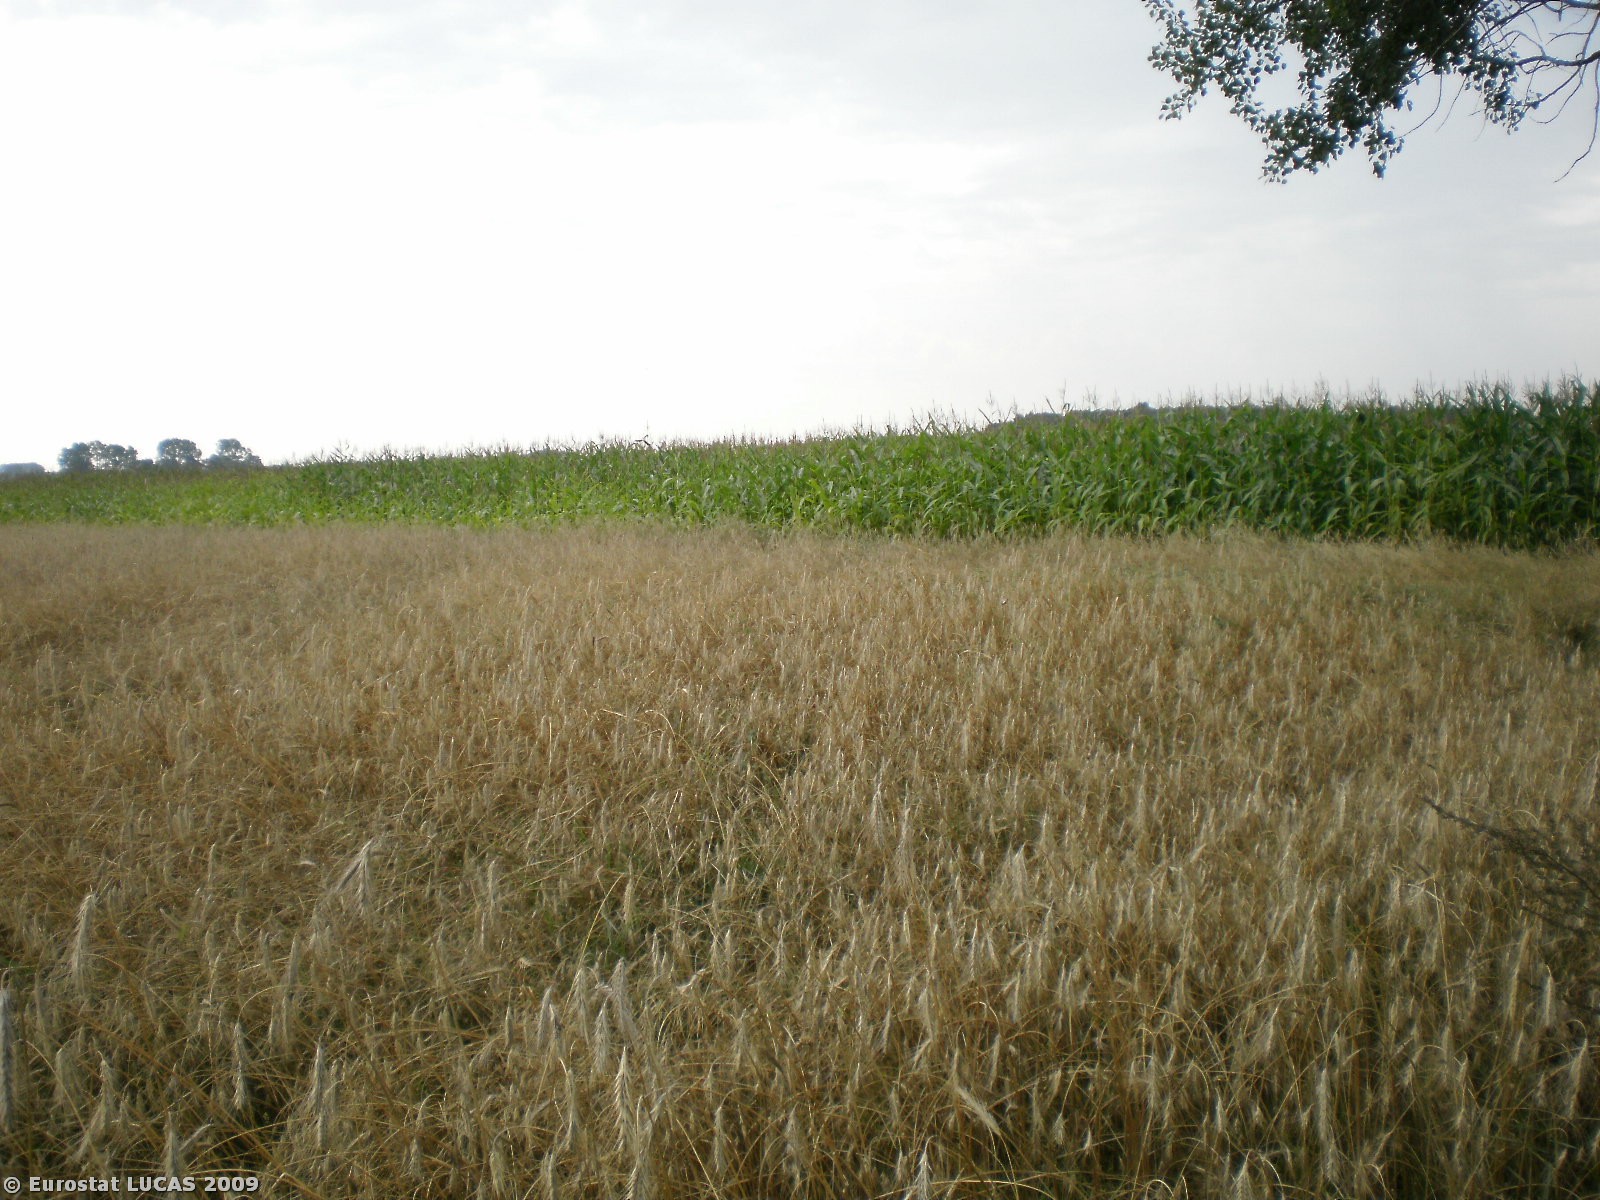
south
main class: Cropland
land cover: Maize
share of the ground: > 75 %
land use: Agriculture (excluding fallow land and kitchen gardens)
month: August
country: PL
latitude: 53.0179
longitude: 21.8469
